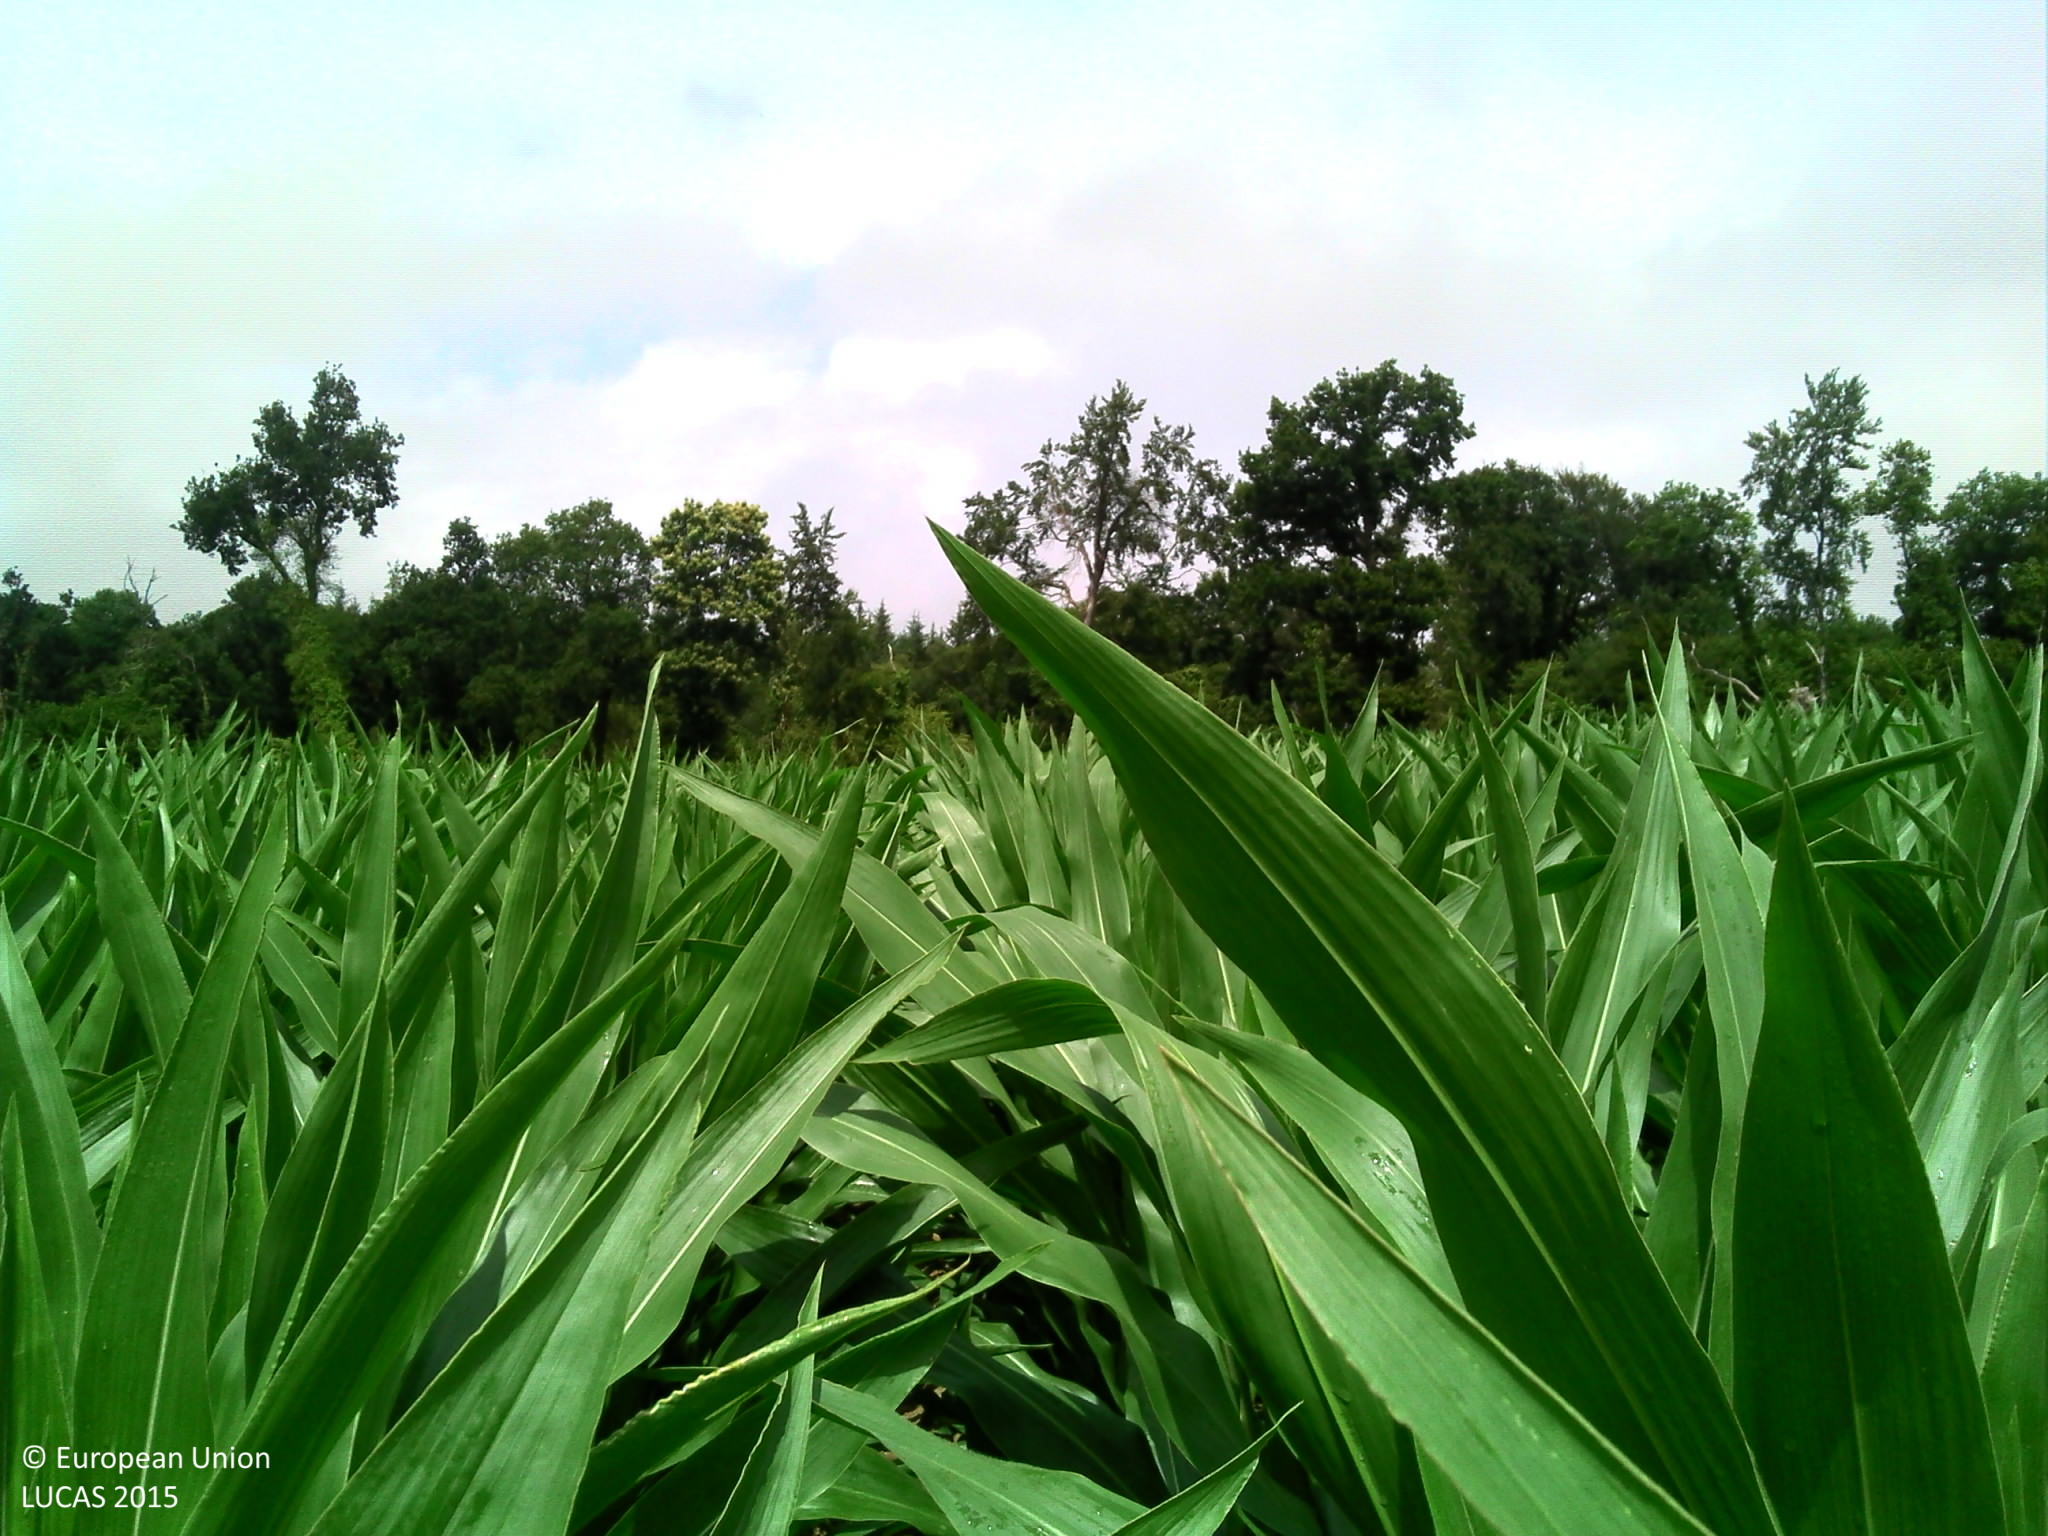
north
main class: Cropland
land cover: Maize
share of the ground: > 75 %
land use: Agriculture (excluding fallow land and kitchen gardens)
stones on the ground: < 10 %
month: July
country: FR
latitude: 48.6179
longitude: -3.4400
